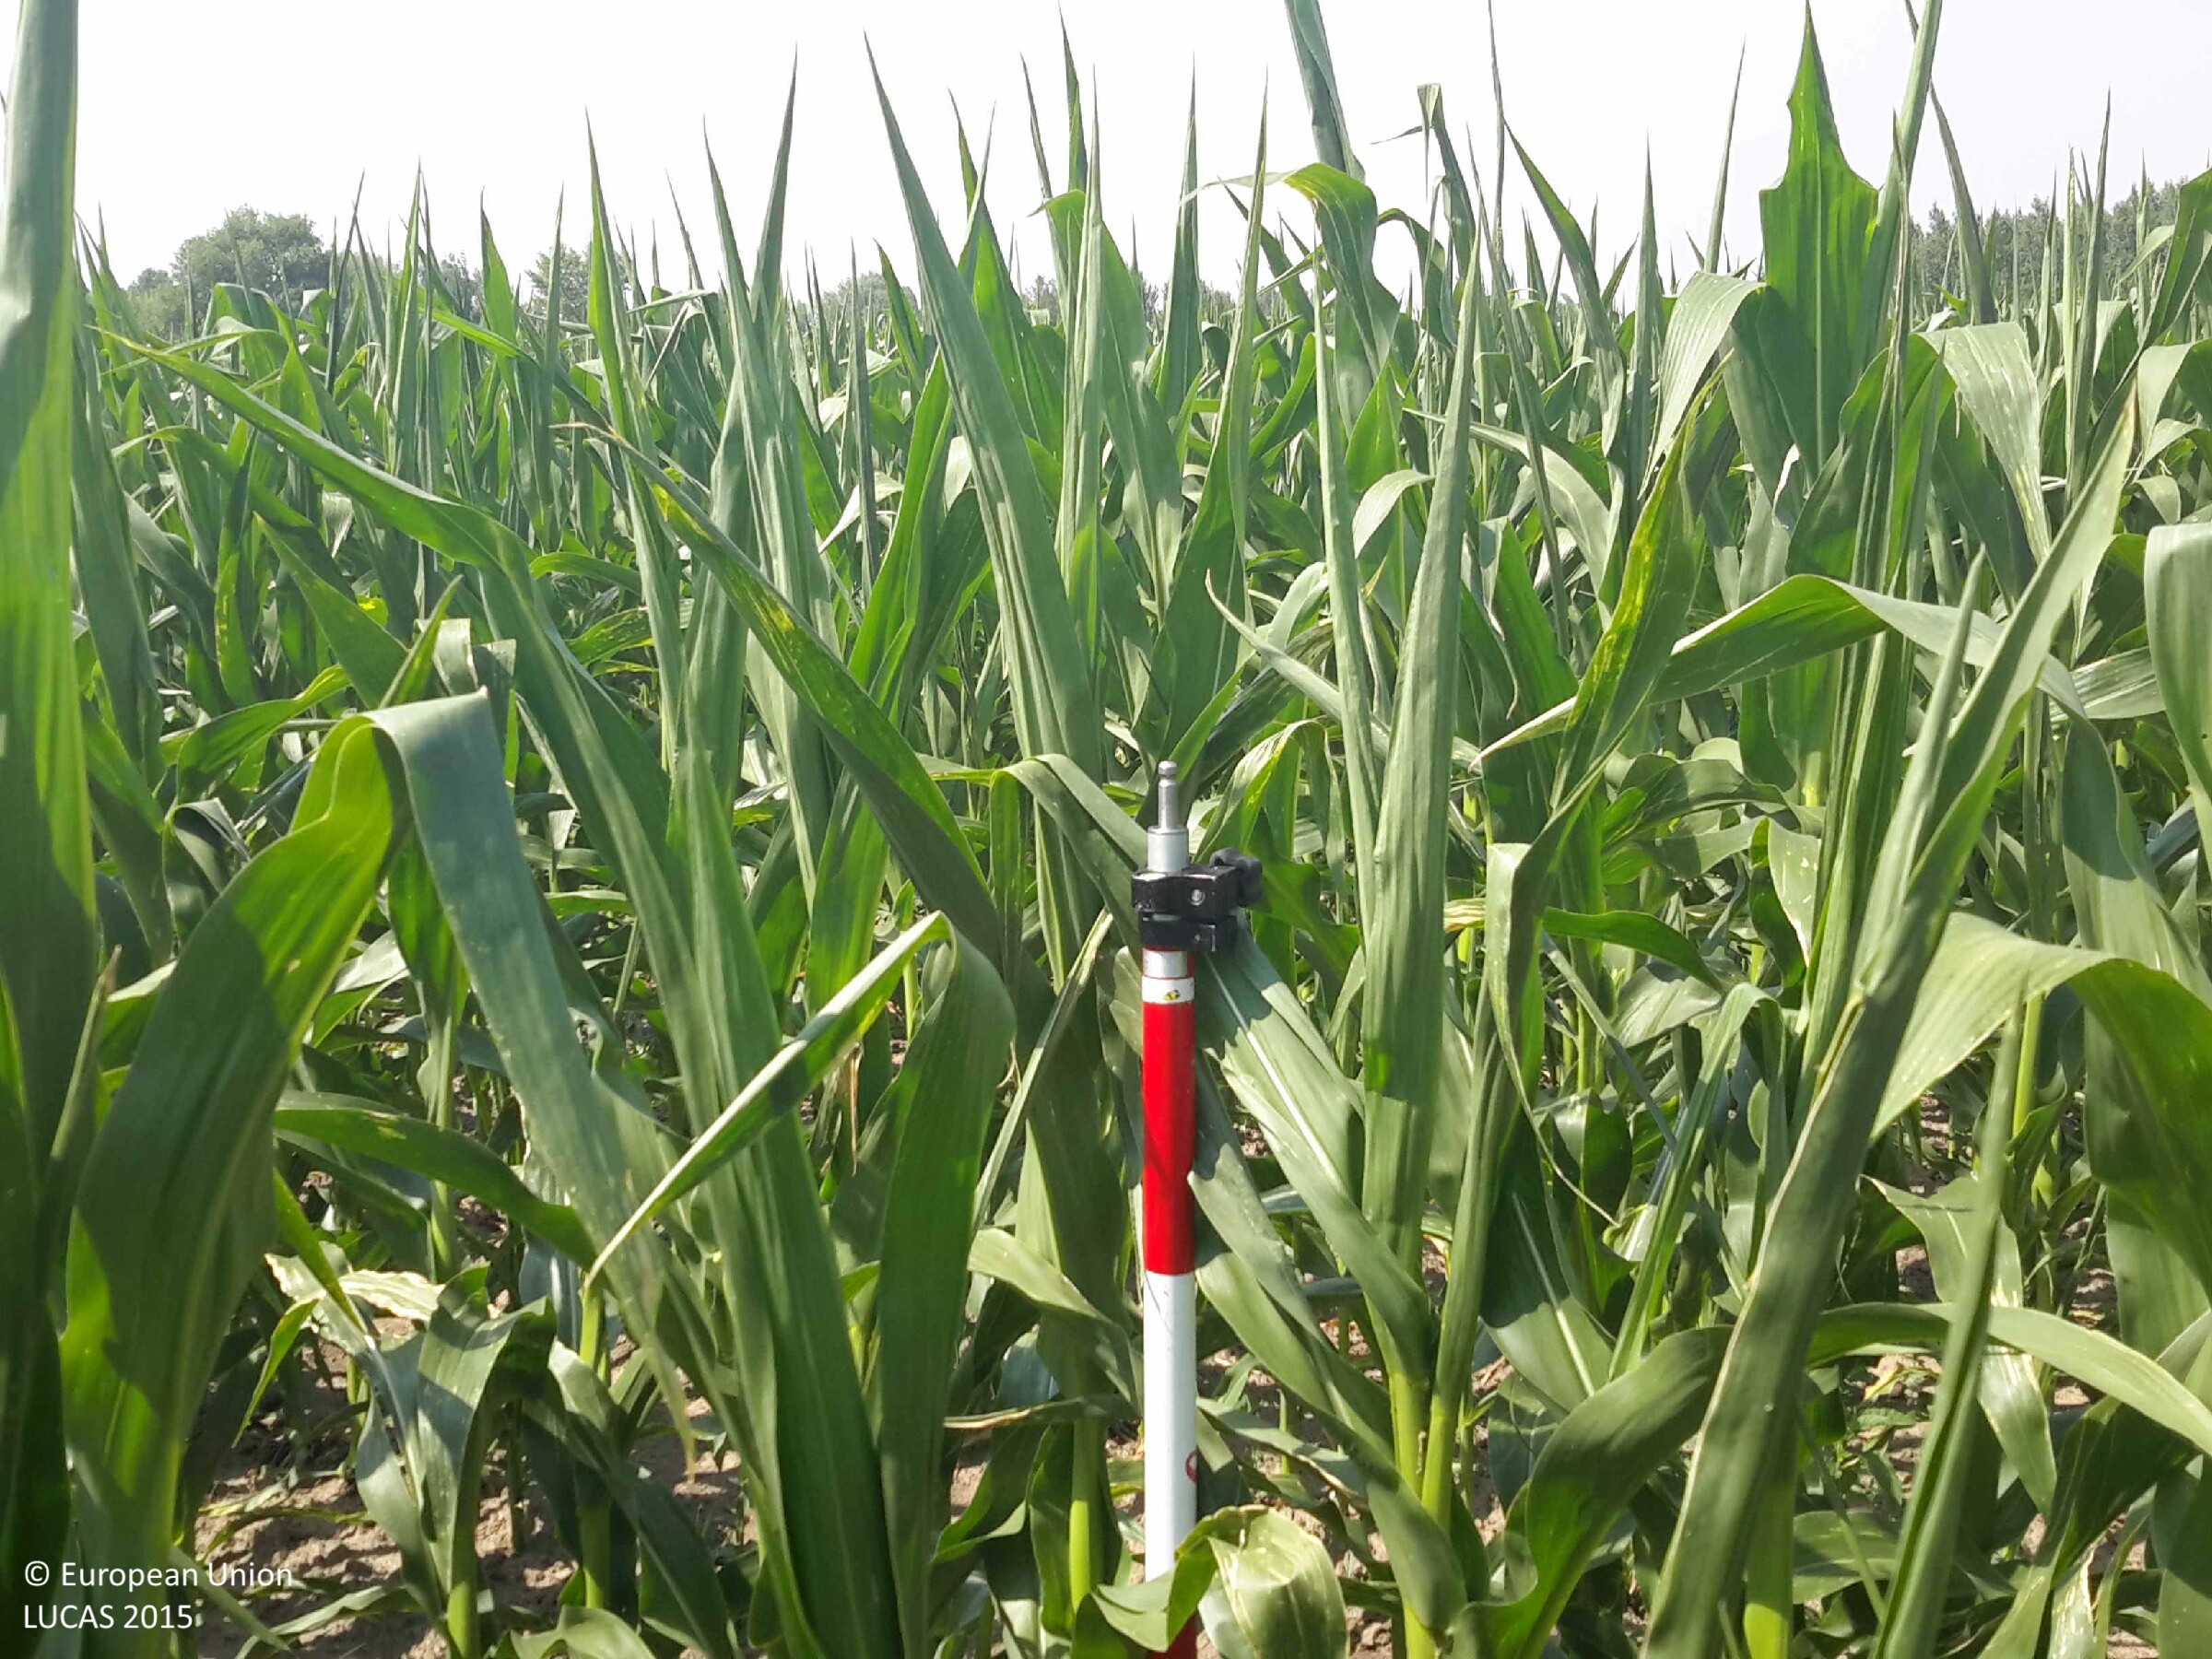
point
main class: Cropland
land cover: Maize
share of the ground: > 75 %
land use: Agriculture (excluding fallow land and kitchen gardens)
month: July
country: HU
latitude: 47.2826
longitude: 17.2114
